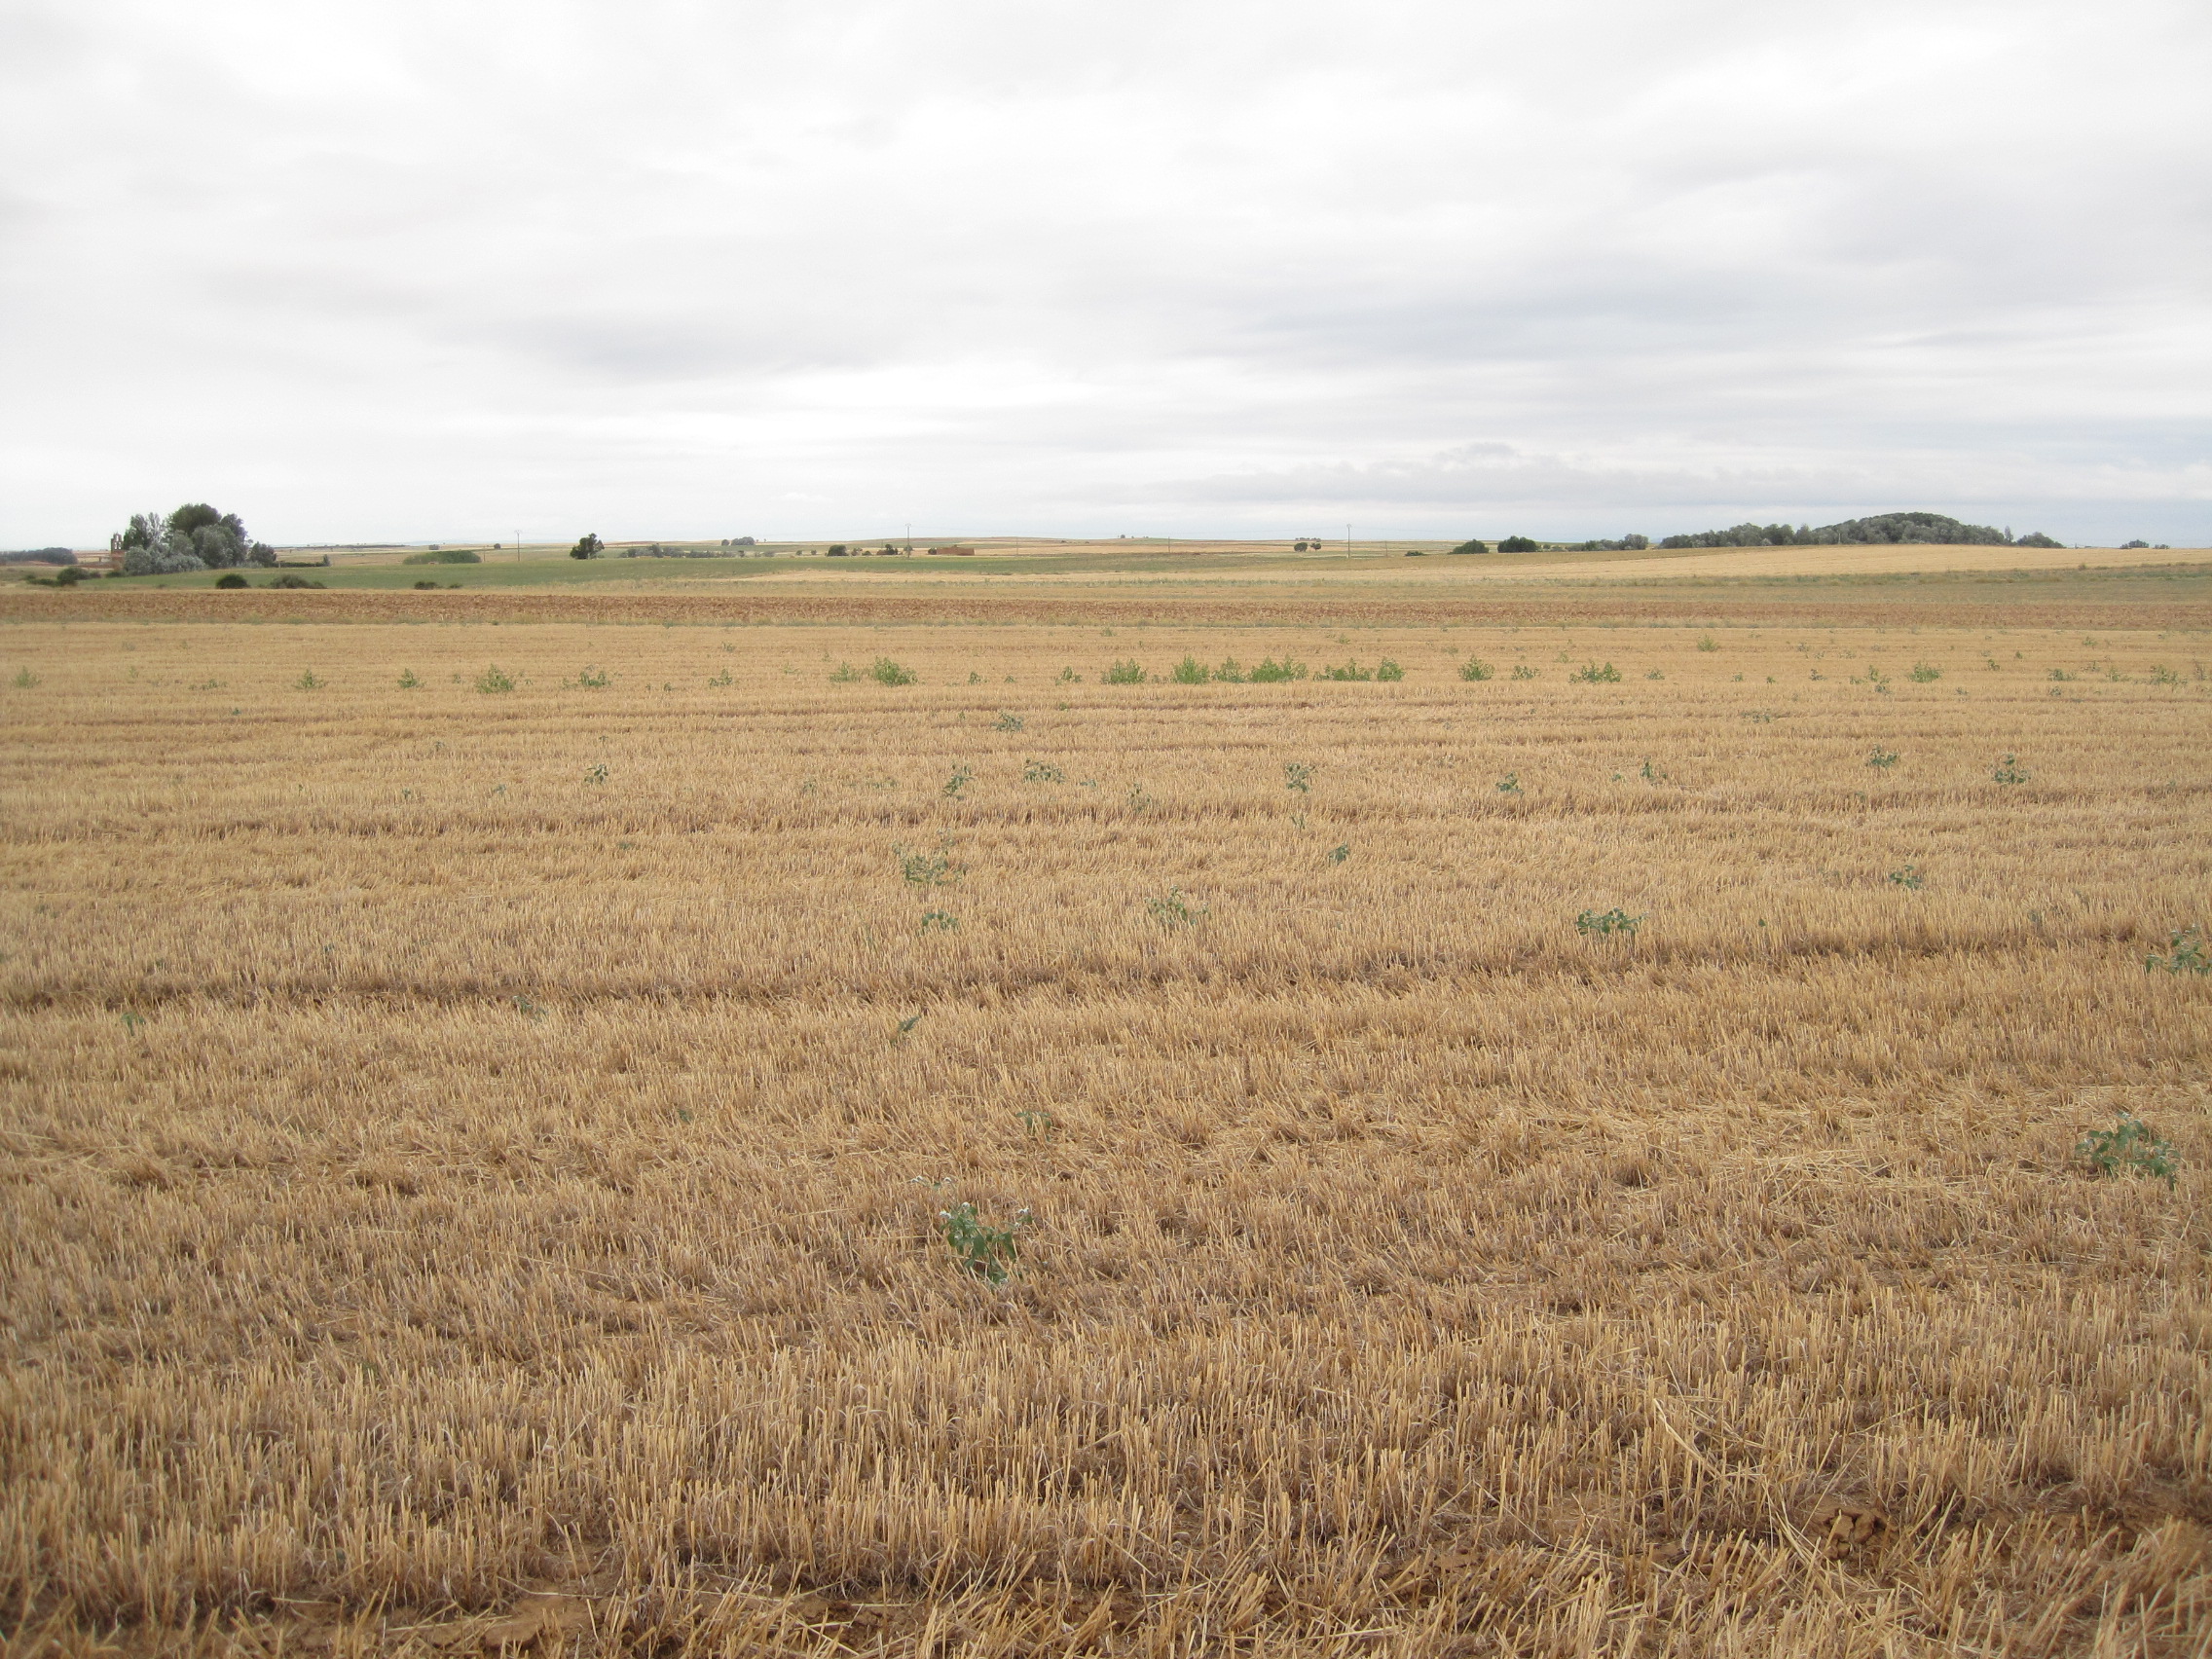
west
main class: Cropland
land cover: Barley
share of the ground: < 10 %
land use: Agriculture (excluding fallow land and kitchen gardens)
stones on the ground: < 10 %
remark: Harvested field
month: July
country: ES
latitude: 41.9743
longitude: -5.4493
